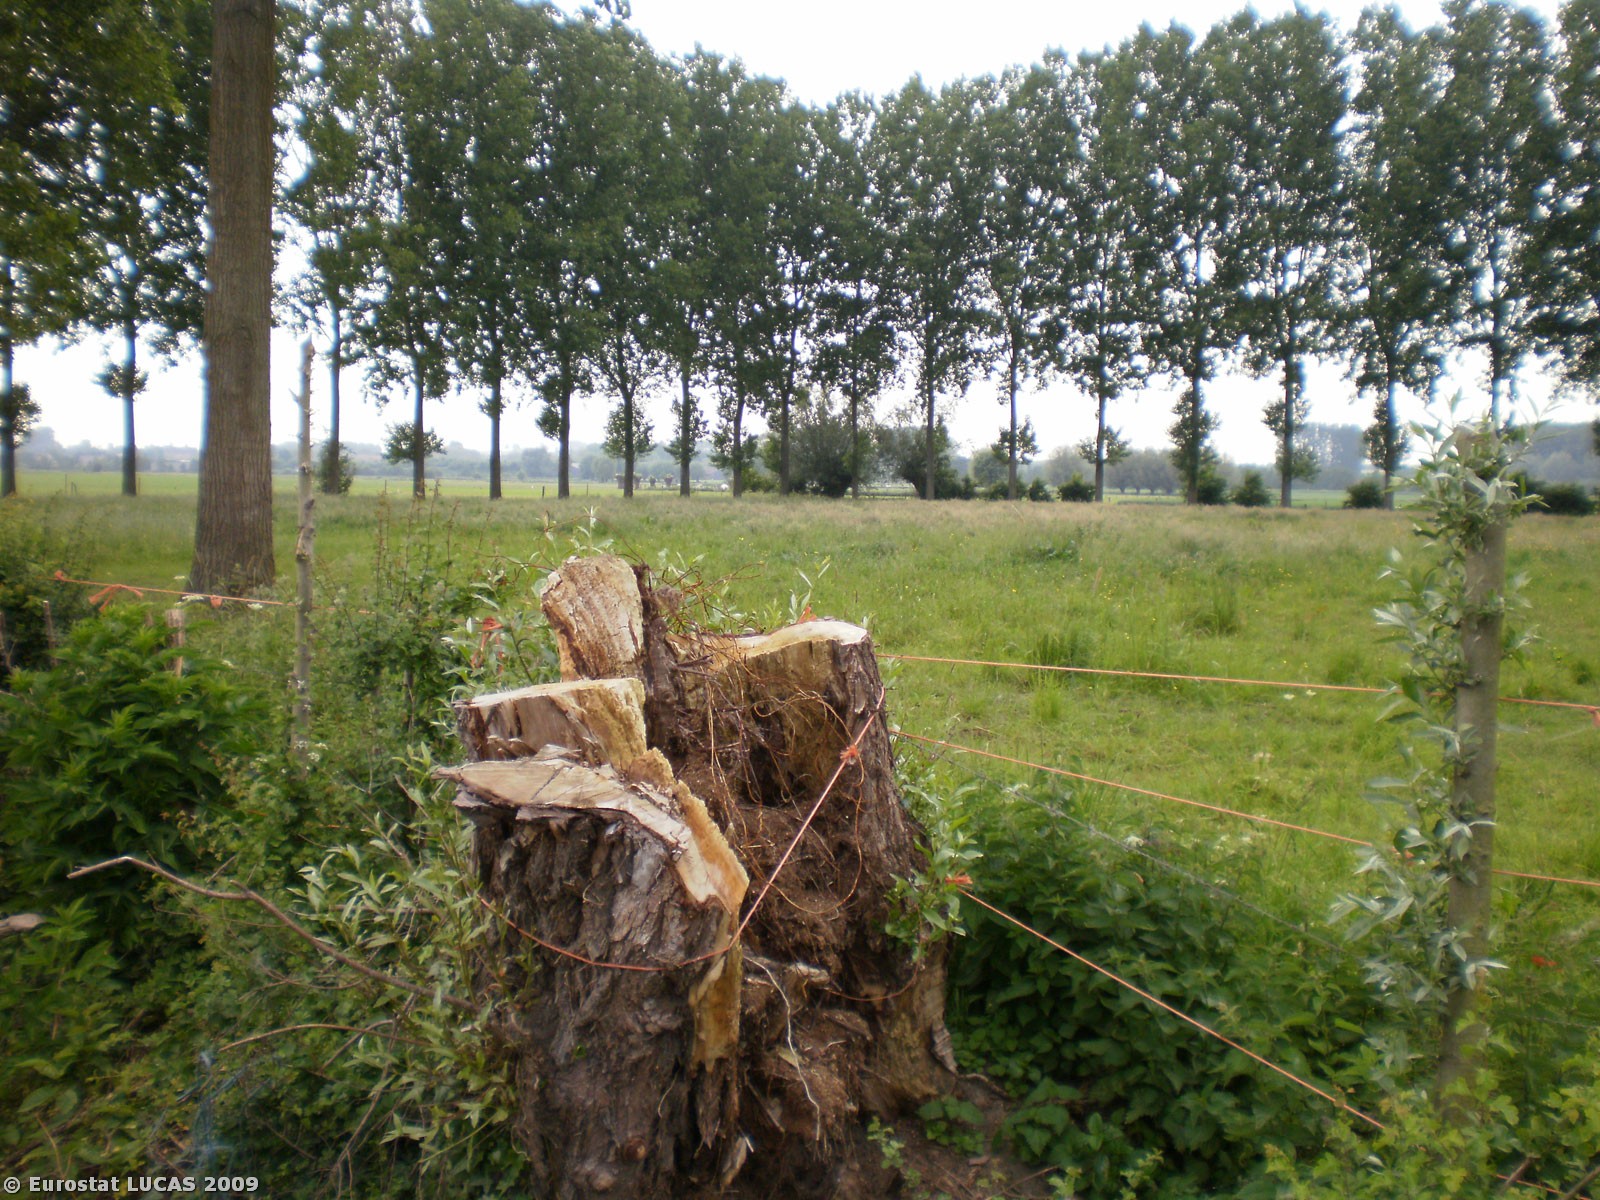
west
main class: Grassland
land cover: Grassland without tree/shrub cover
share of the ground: > 75 %
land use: Agriculture (excluding fallow land and kitchen gardens)
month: May
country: BE
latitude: 50.6653
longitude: 3.8108
